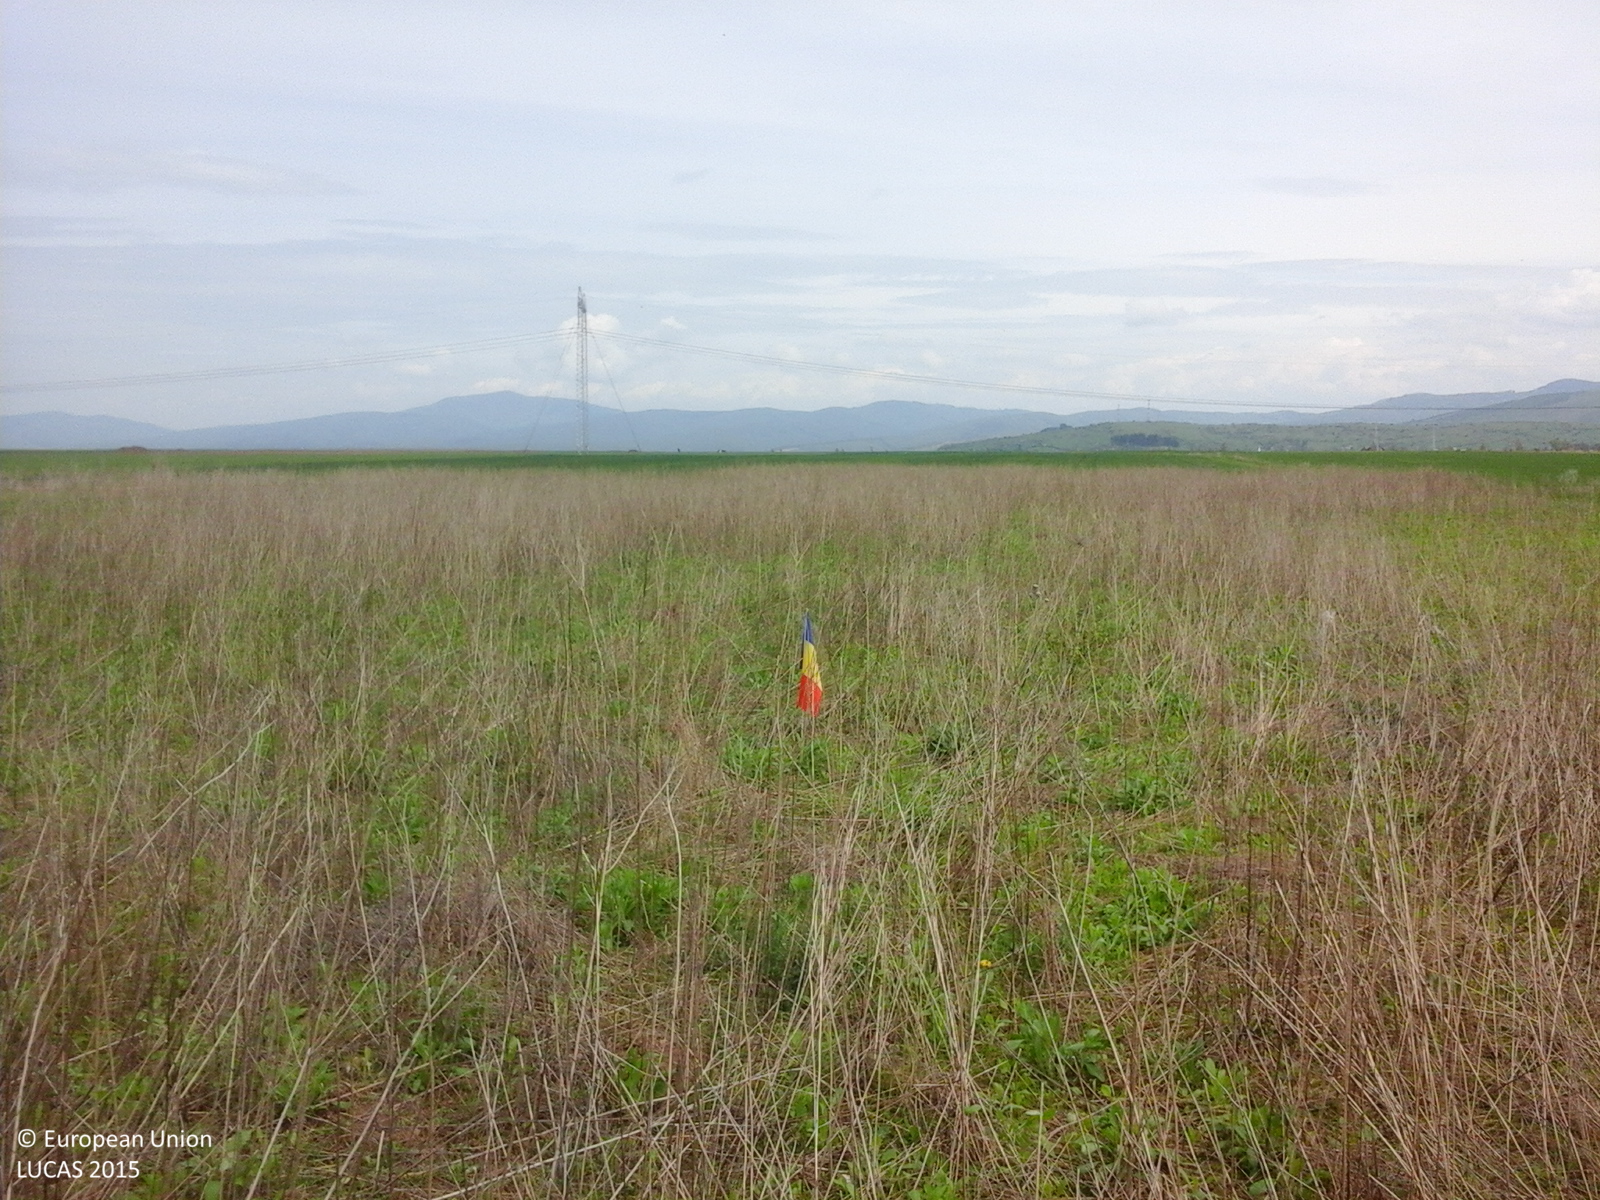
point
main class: Grassland
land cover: Grassland without tree/shrub cover
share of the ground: > 75 %
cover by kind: herbaceous plants 100 %
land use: Agriculture (excluding fallow land and kitchen gardens)
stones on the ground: 10 - 25 %
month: May
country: RO
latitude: 45.6380
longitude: 25.7201
